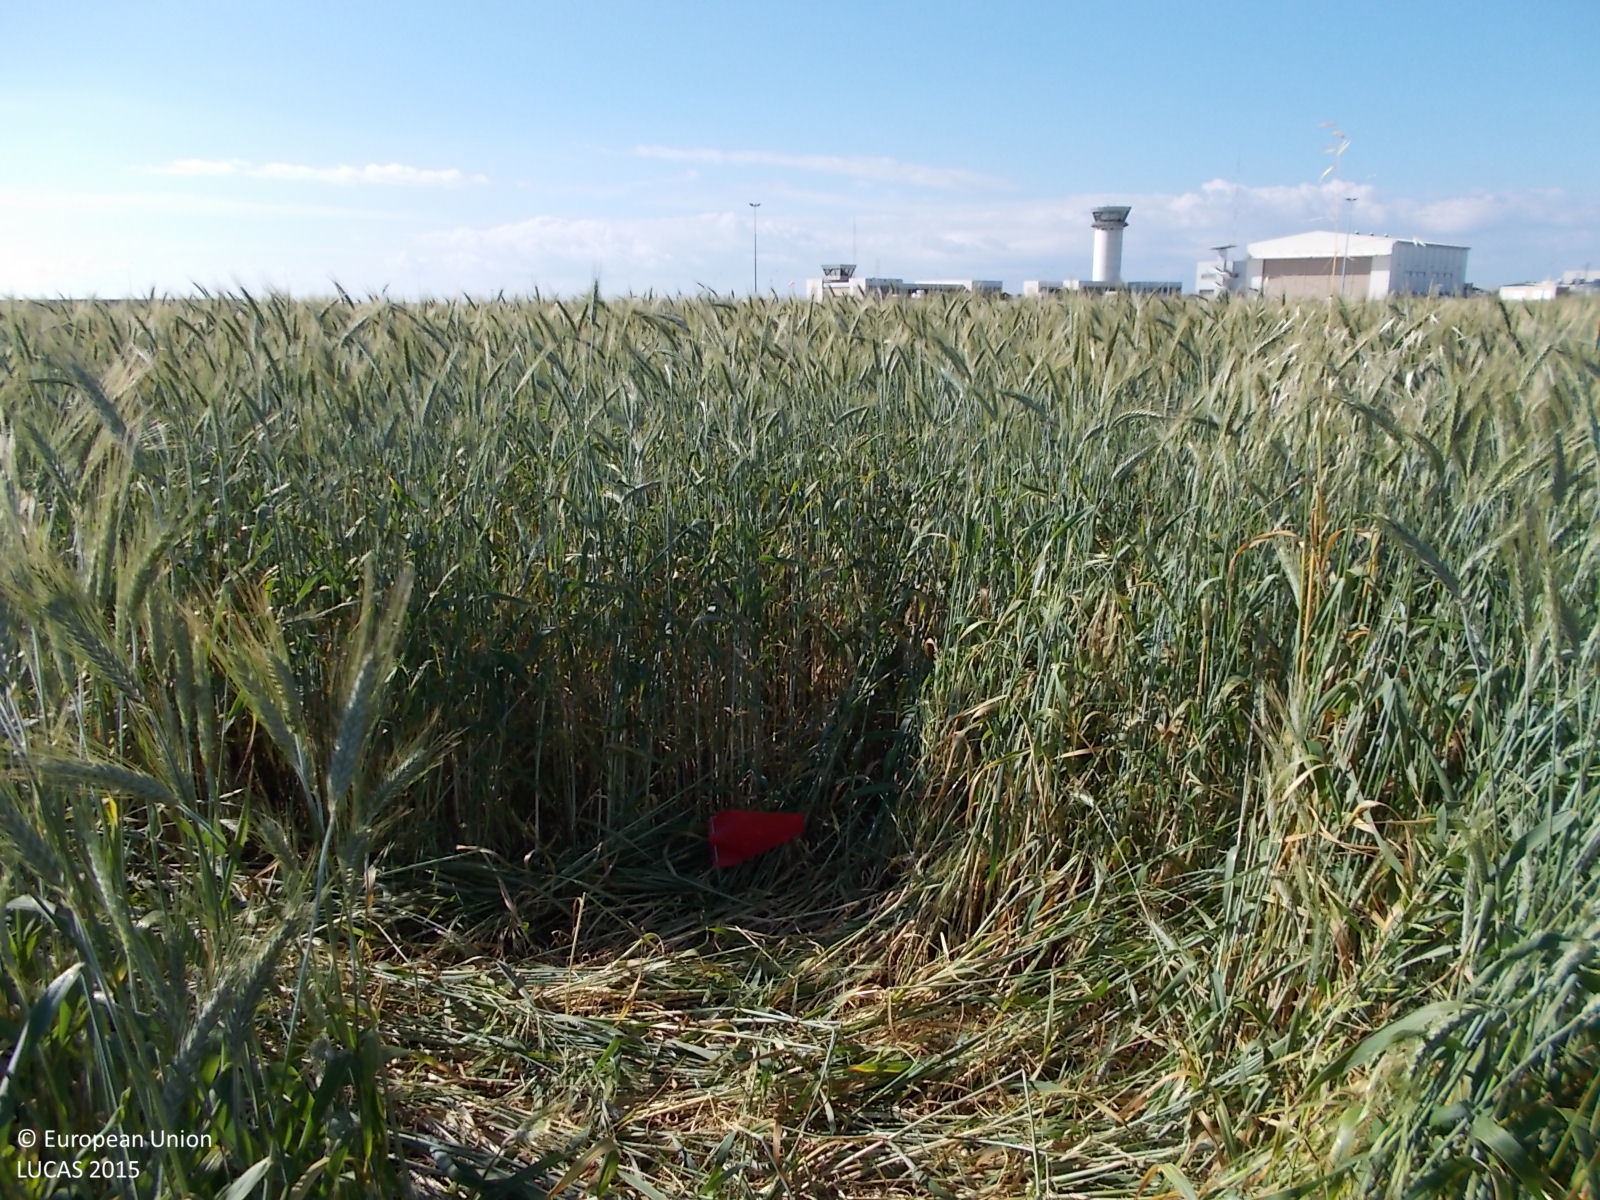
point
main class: Cropland
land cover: Common wheat
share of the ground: > 75 %
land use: Agriculture (excluding fallow land and kitchen gardens)
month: April
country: CY
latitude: 34.8777
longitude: 33.6182
